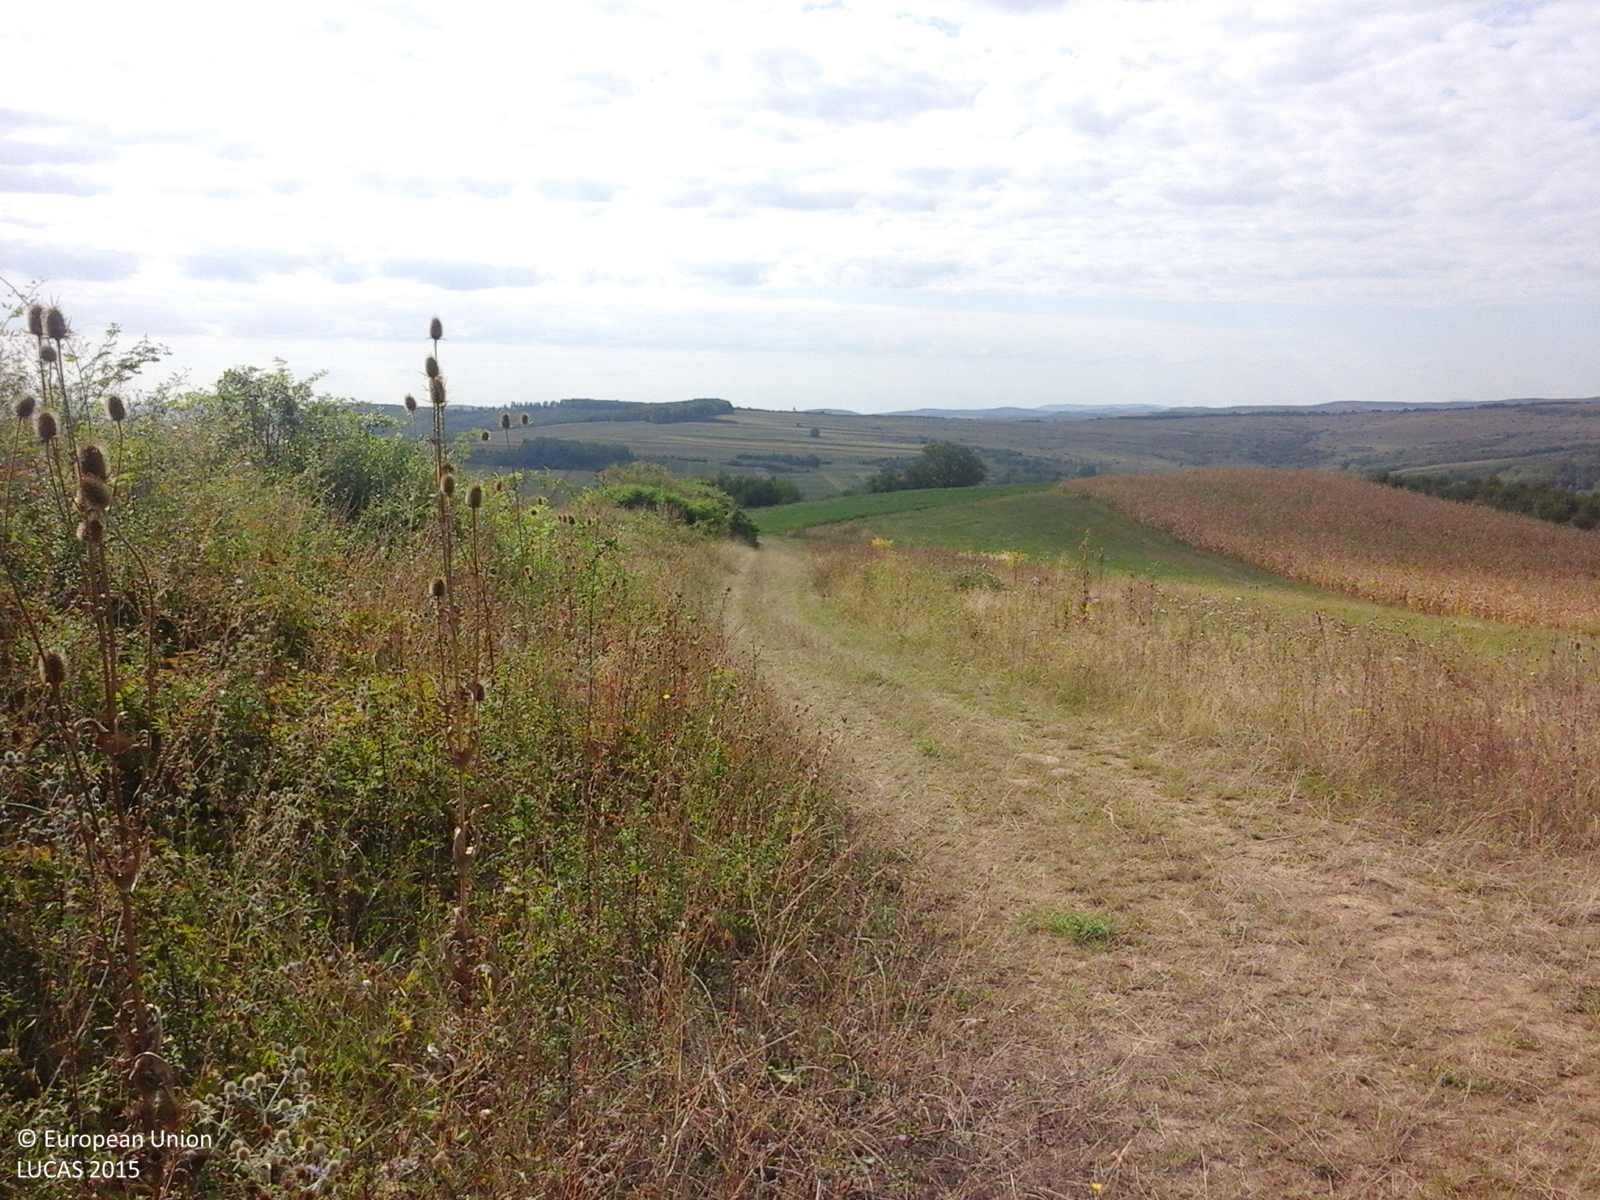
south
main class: Grassland
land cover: Spontaneously vegetated surfaces
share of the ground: > 75 %
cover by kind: herbaceous plants 100 %
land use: Fallow land
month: September
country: RO
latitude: 47.4571
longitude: 23.2405
